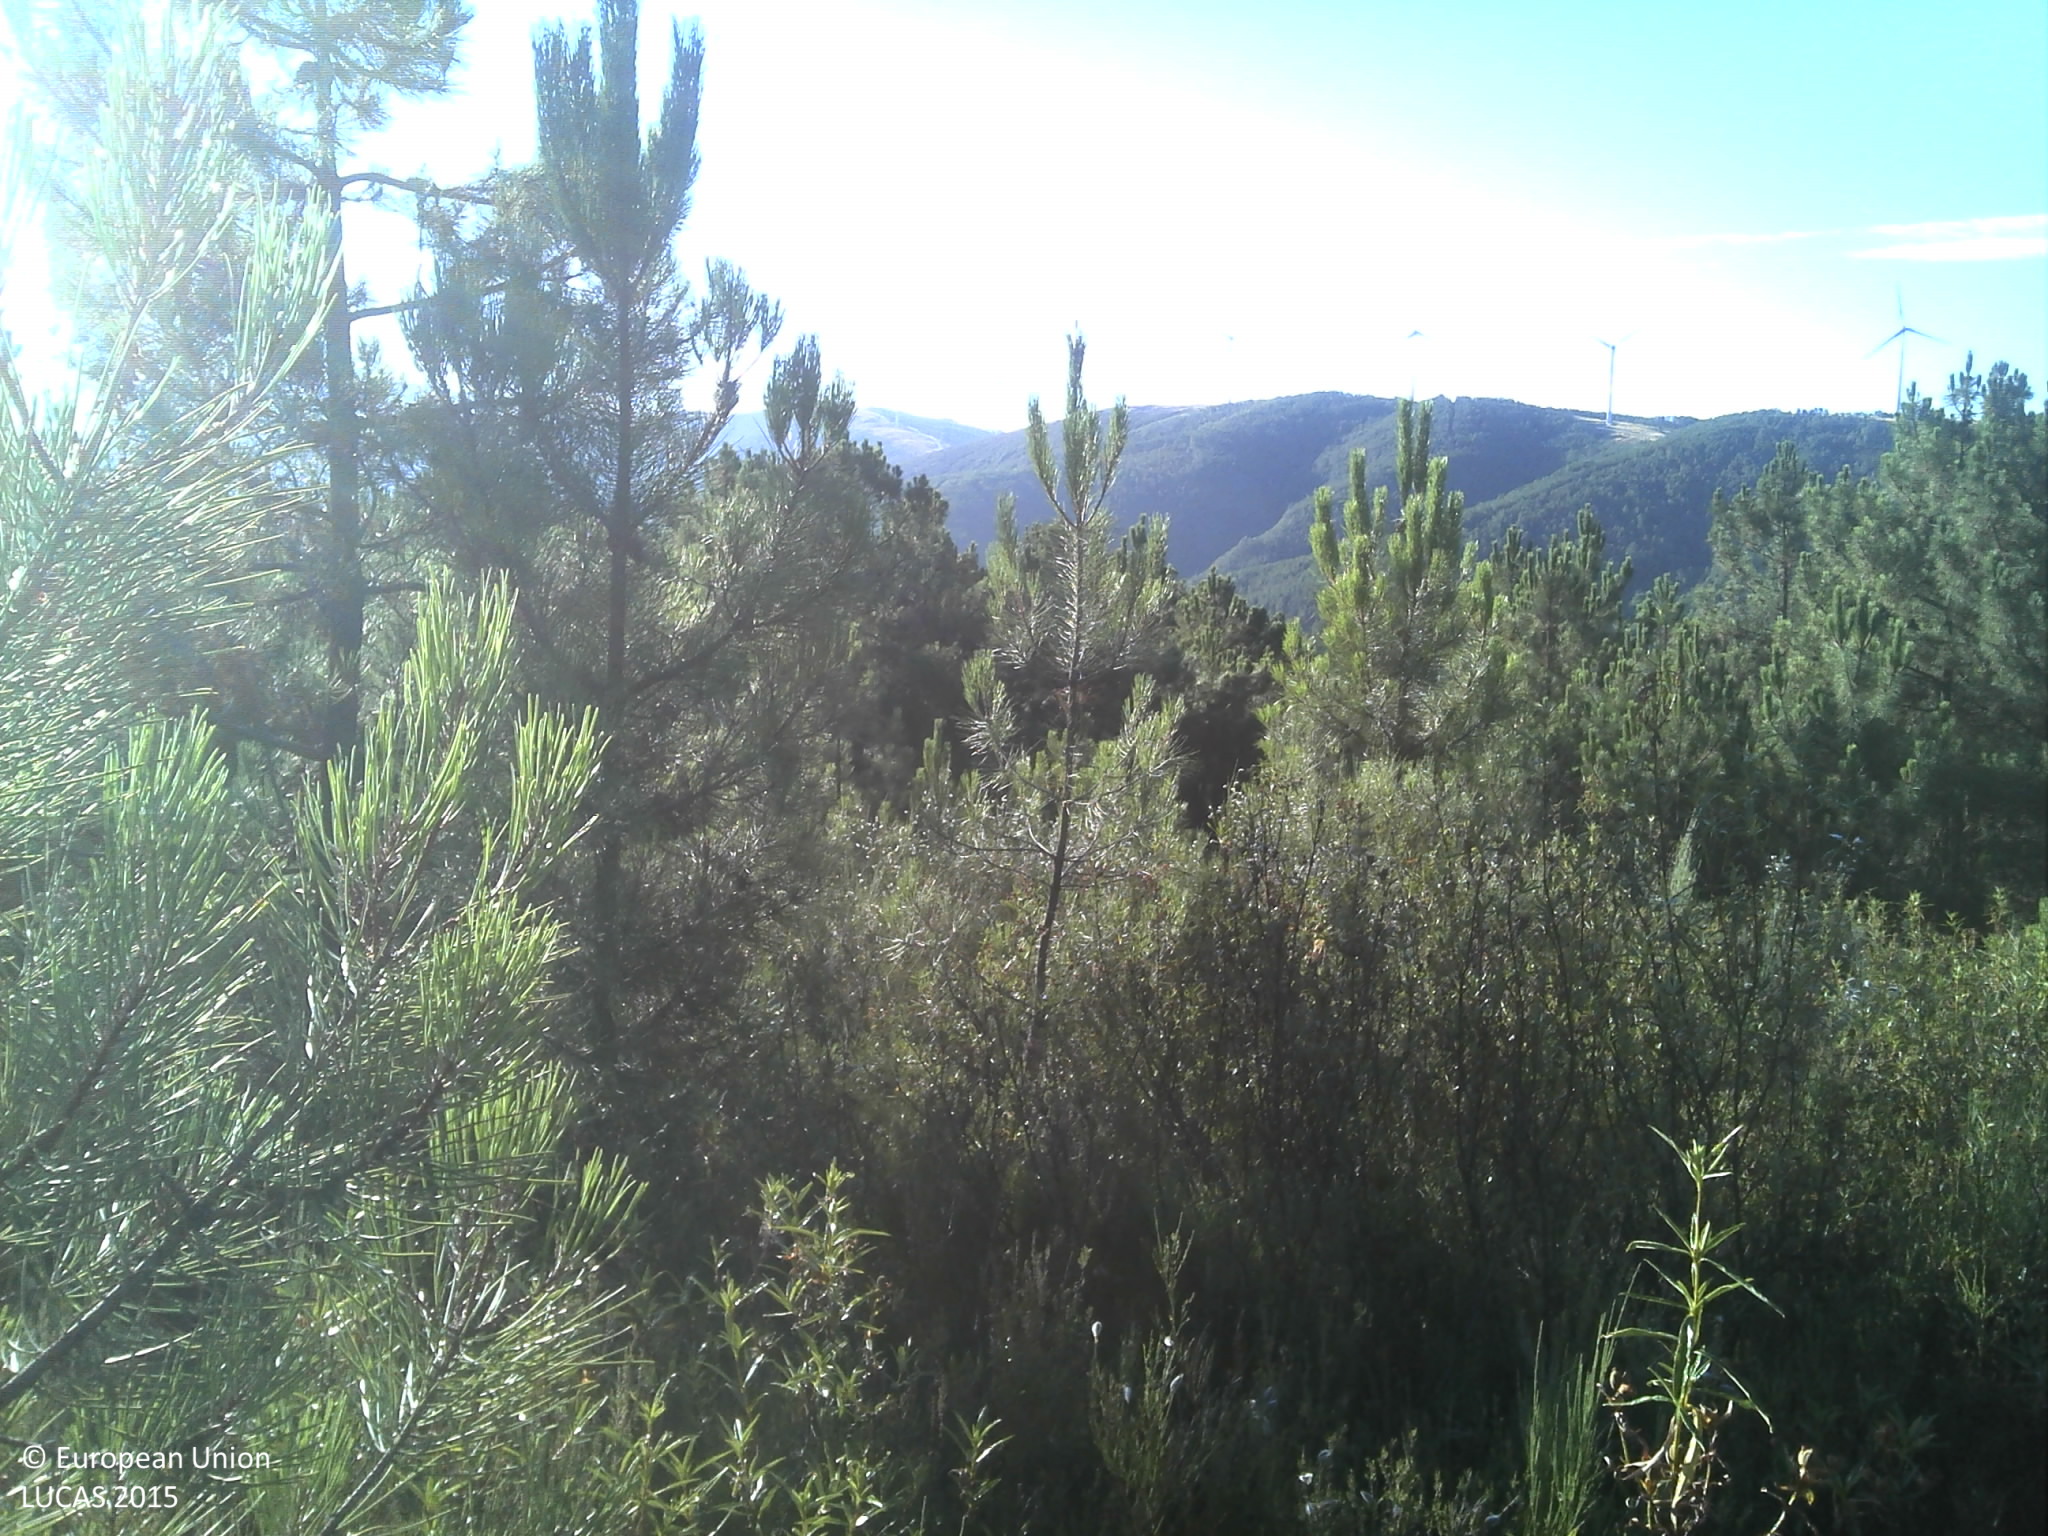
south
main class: Shrubland
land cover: Shrubland without tree cover
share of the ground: 50 - 75 %
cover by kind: shrubs 65 %, unconsolidated bare surface 35 %
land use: Forestry
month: July
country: PT
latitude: 40.0943
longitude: -7.6430
